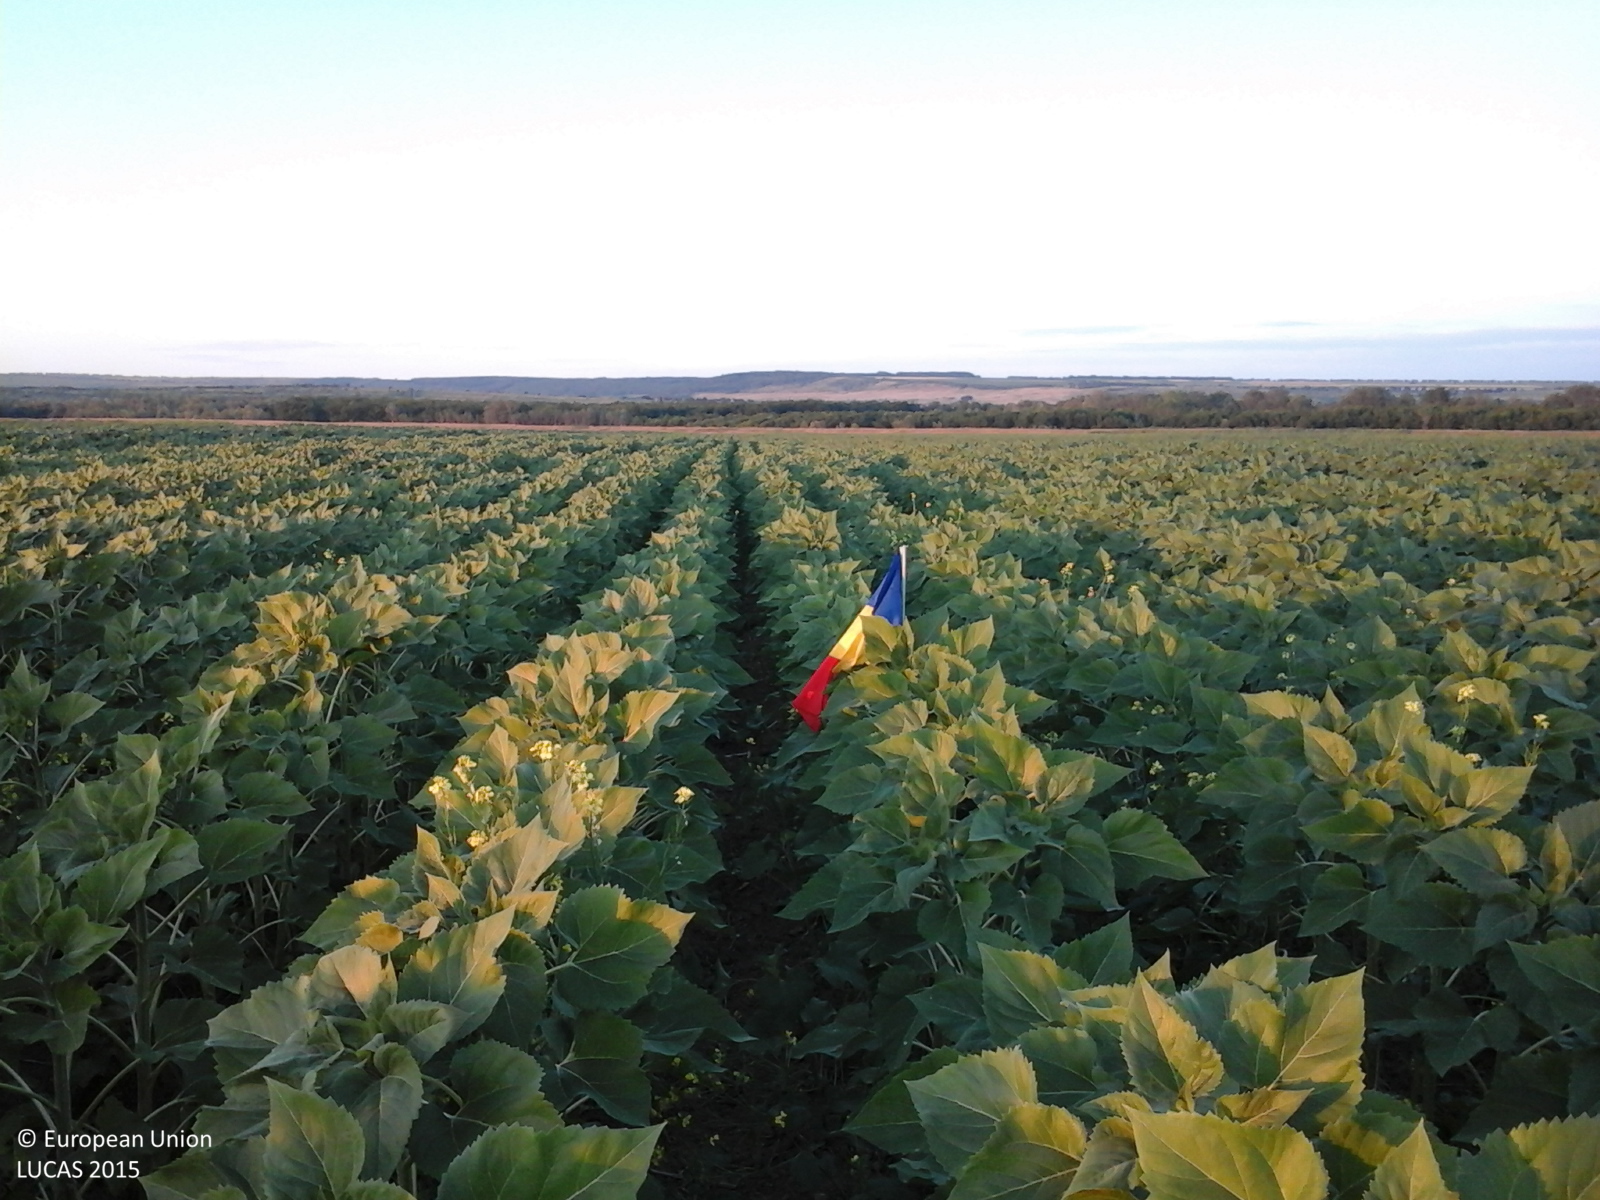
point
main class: Cropland
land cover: Sunflower
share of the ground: 50 - 75 %
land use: Agriculture (excluding fallow land and kitchen gardens)
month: June
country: RO
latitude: 46.9707
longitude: 28.0742
